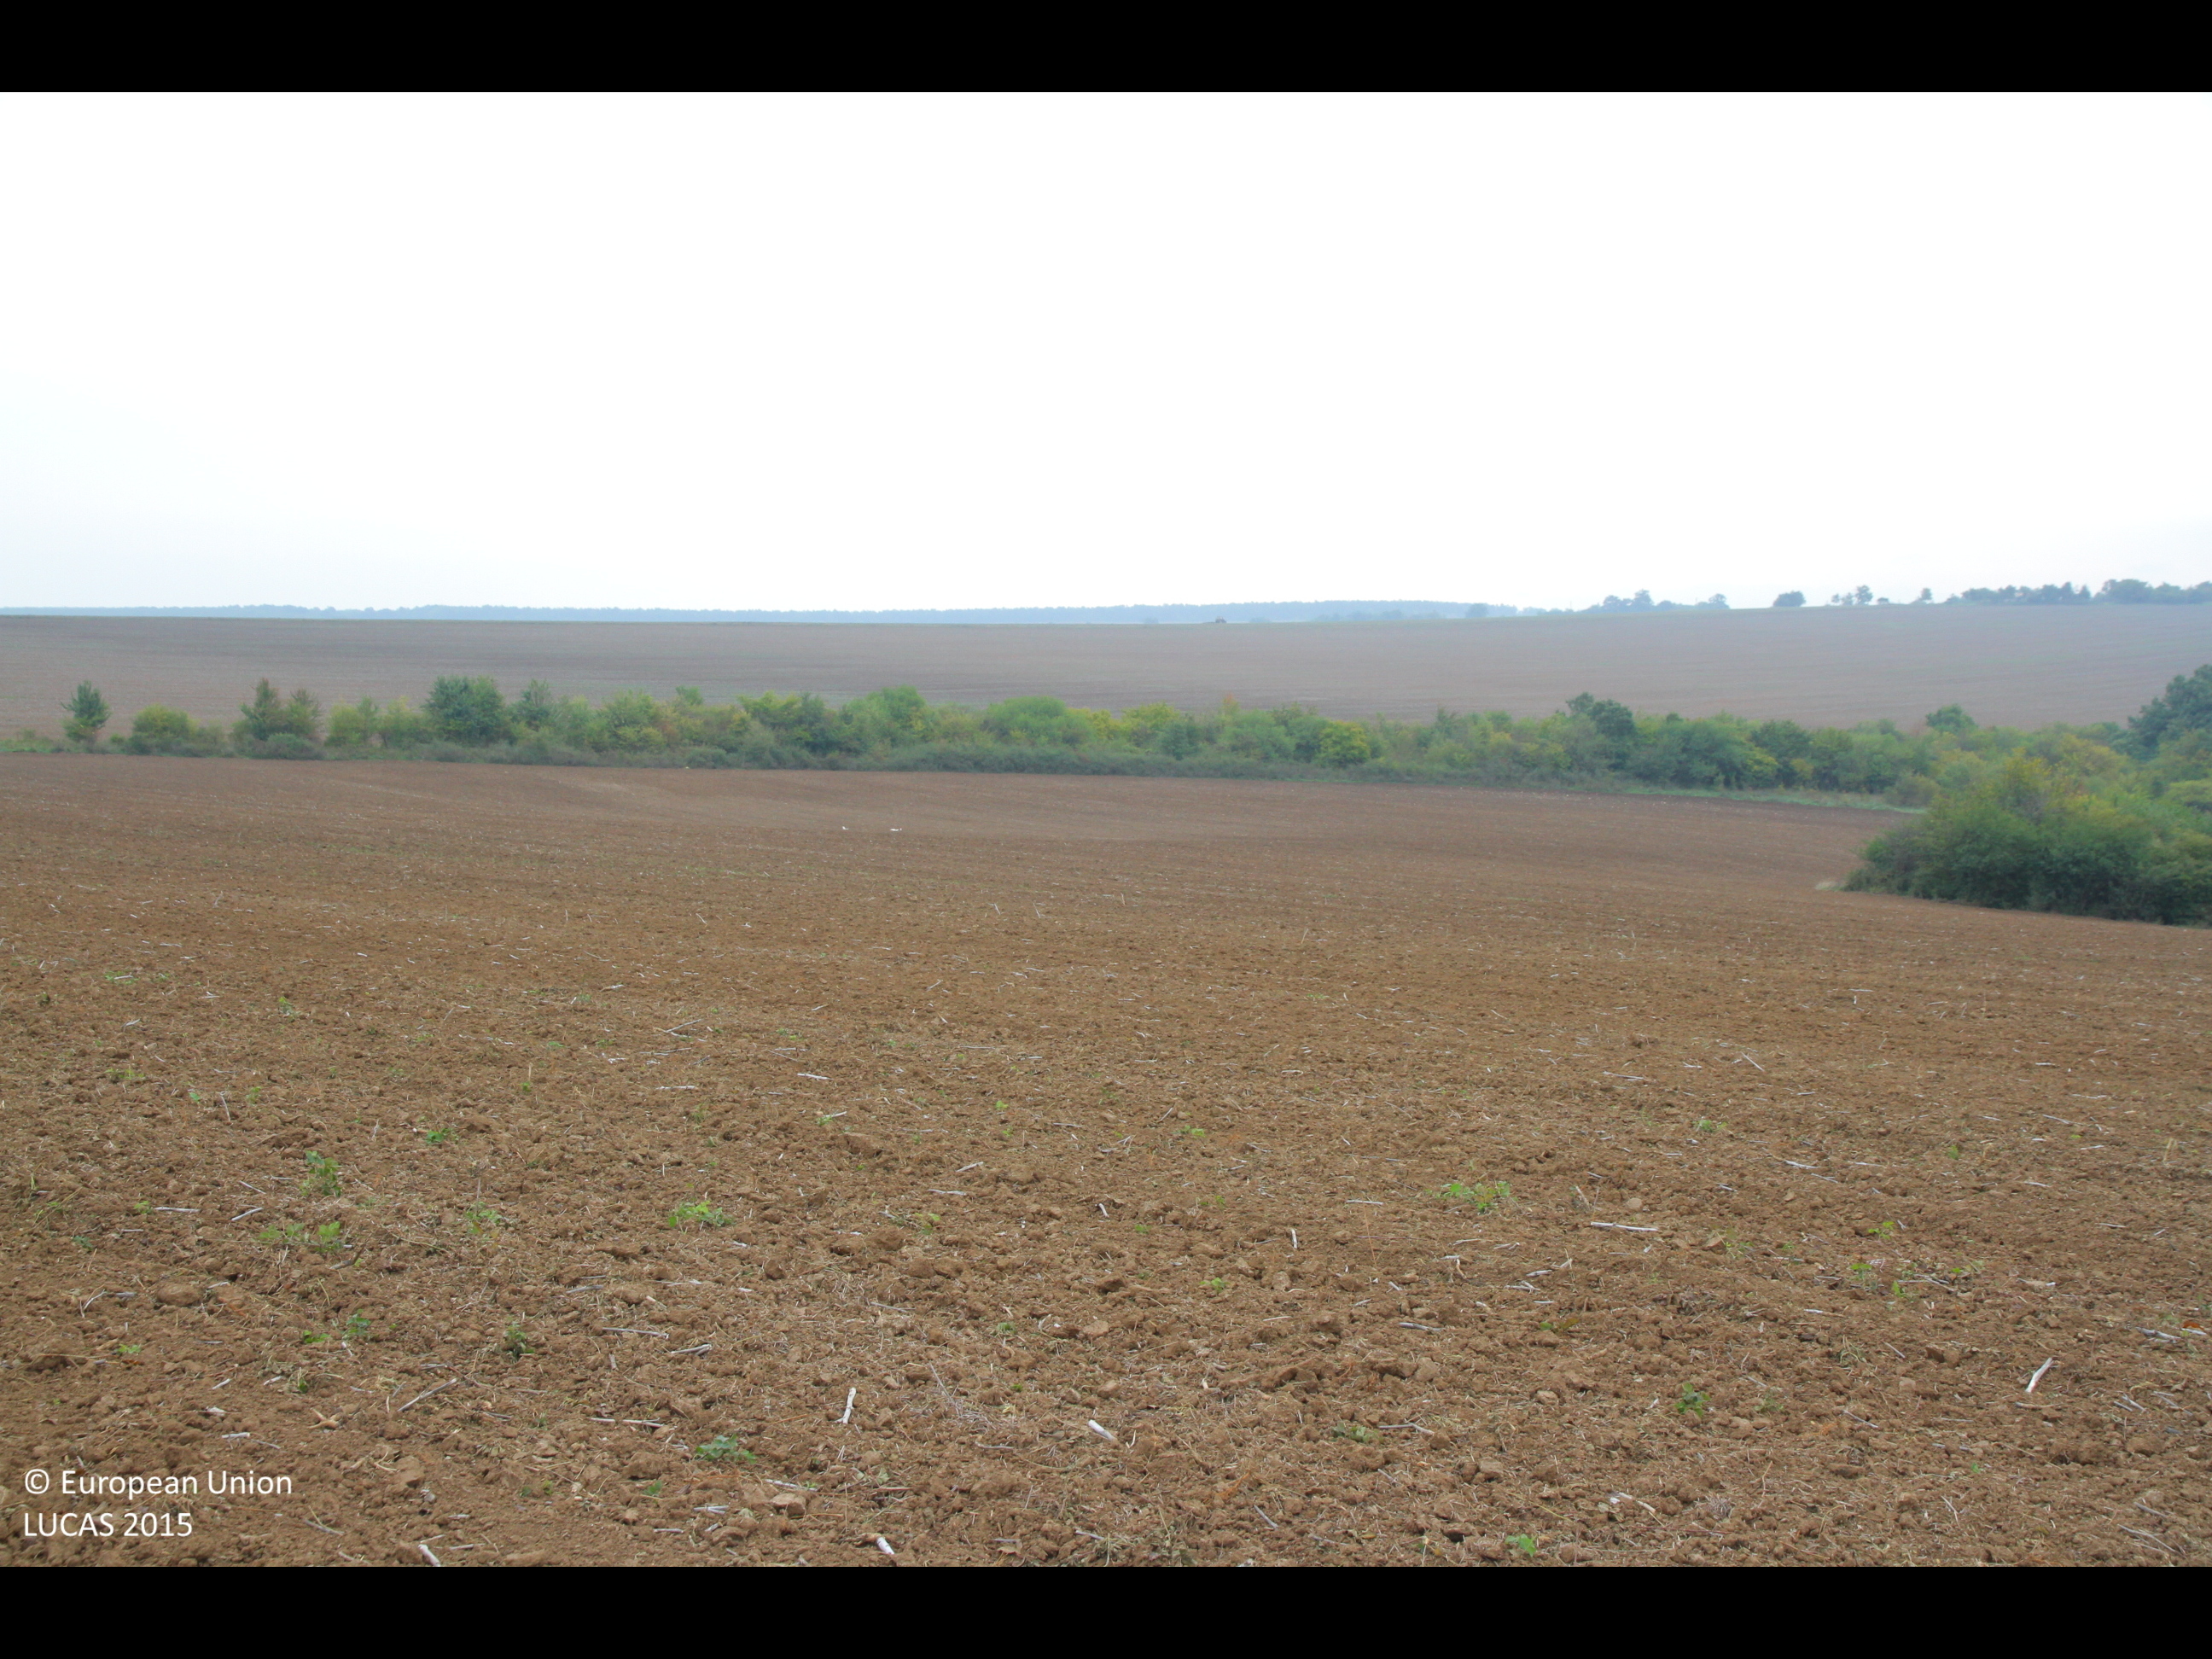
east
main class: Cropland
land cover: Rape and turnip rape
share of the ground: < 10 %
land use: Agriculture (excluding fallow land and kitchen gardens)
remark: Harvested field
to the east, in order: Rape and turnip rape; Grass margins; Shrubland with sparse tree cover
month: October
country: BG
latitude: 43.5015
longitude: 27.0249
